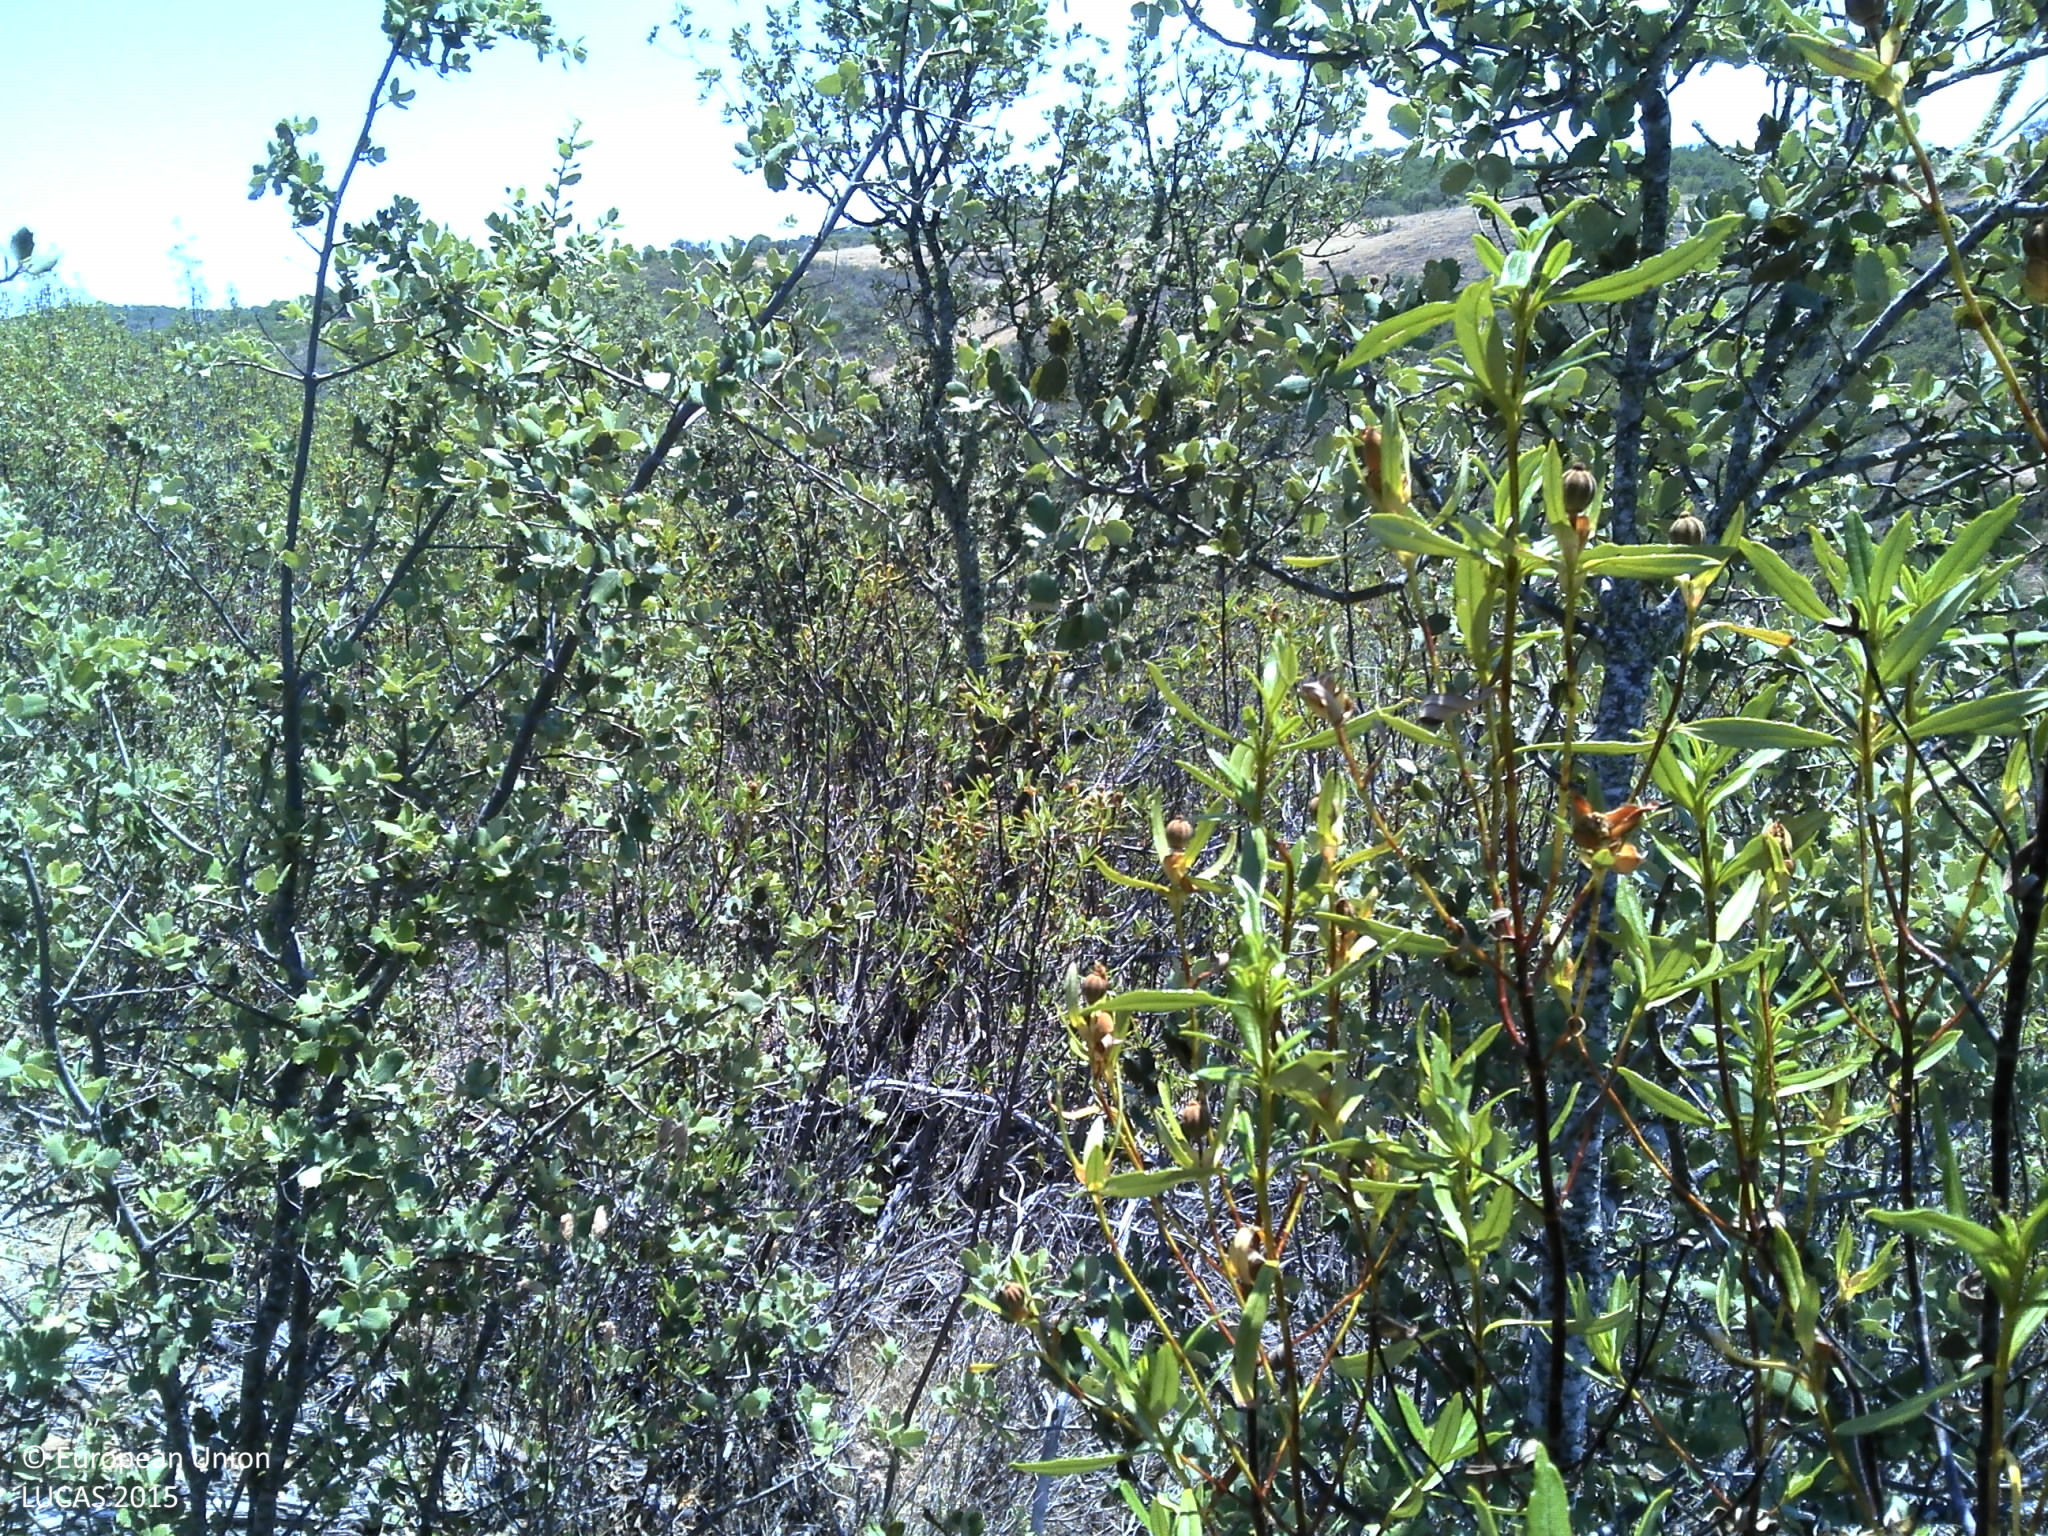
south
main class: Shrubland
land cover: Shrubland without tree cover
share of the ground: > 75 %
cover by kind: shrubs 100 %
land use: Abandoned areas
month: June
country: PT
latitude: 37.4040
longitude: -7.8994
